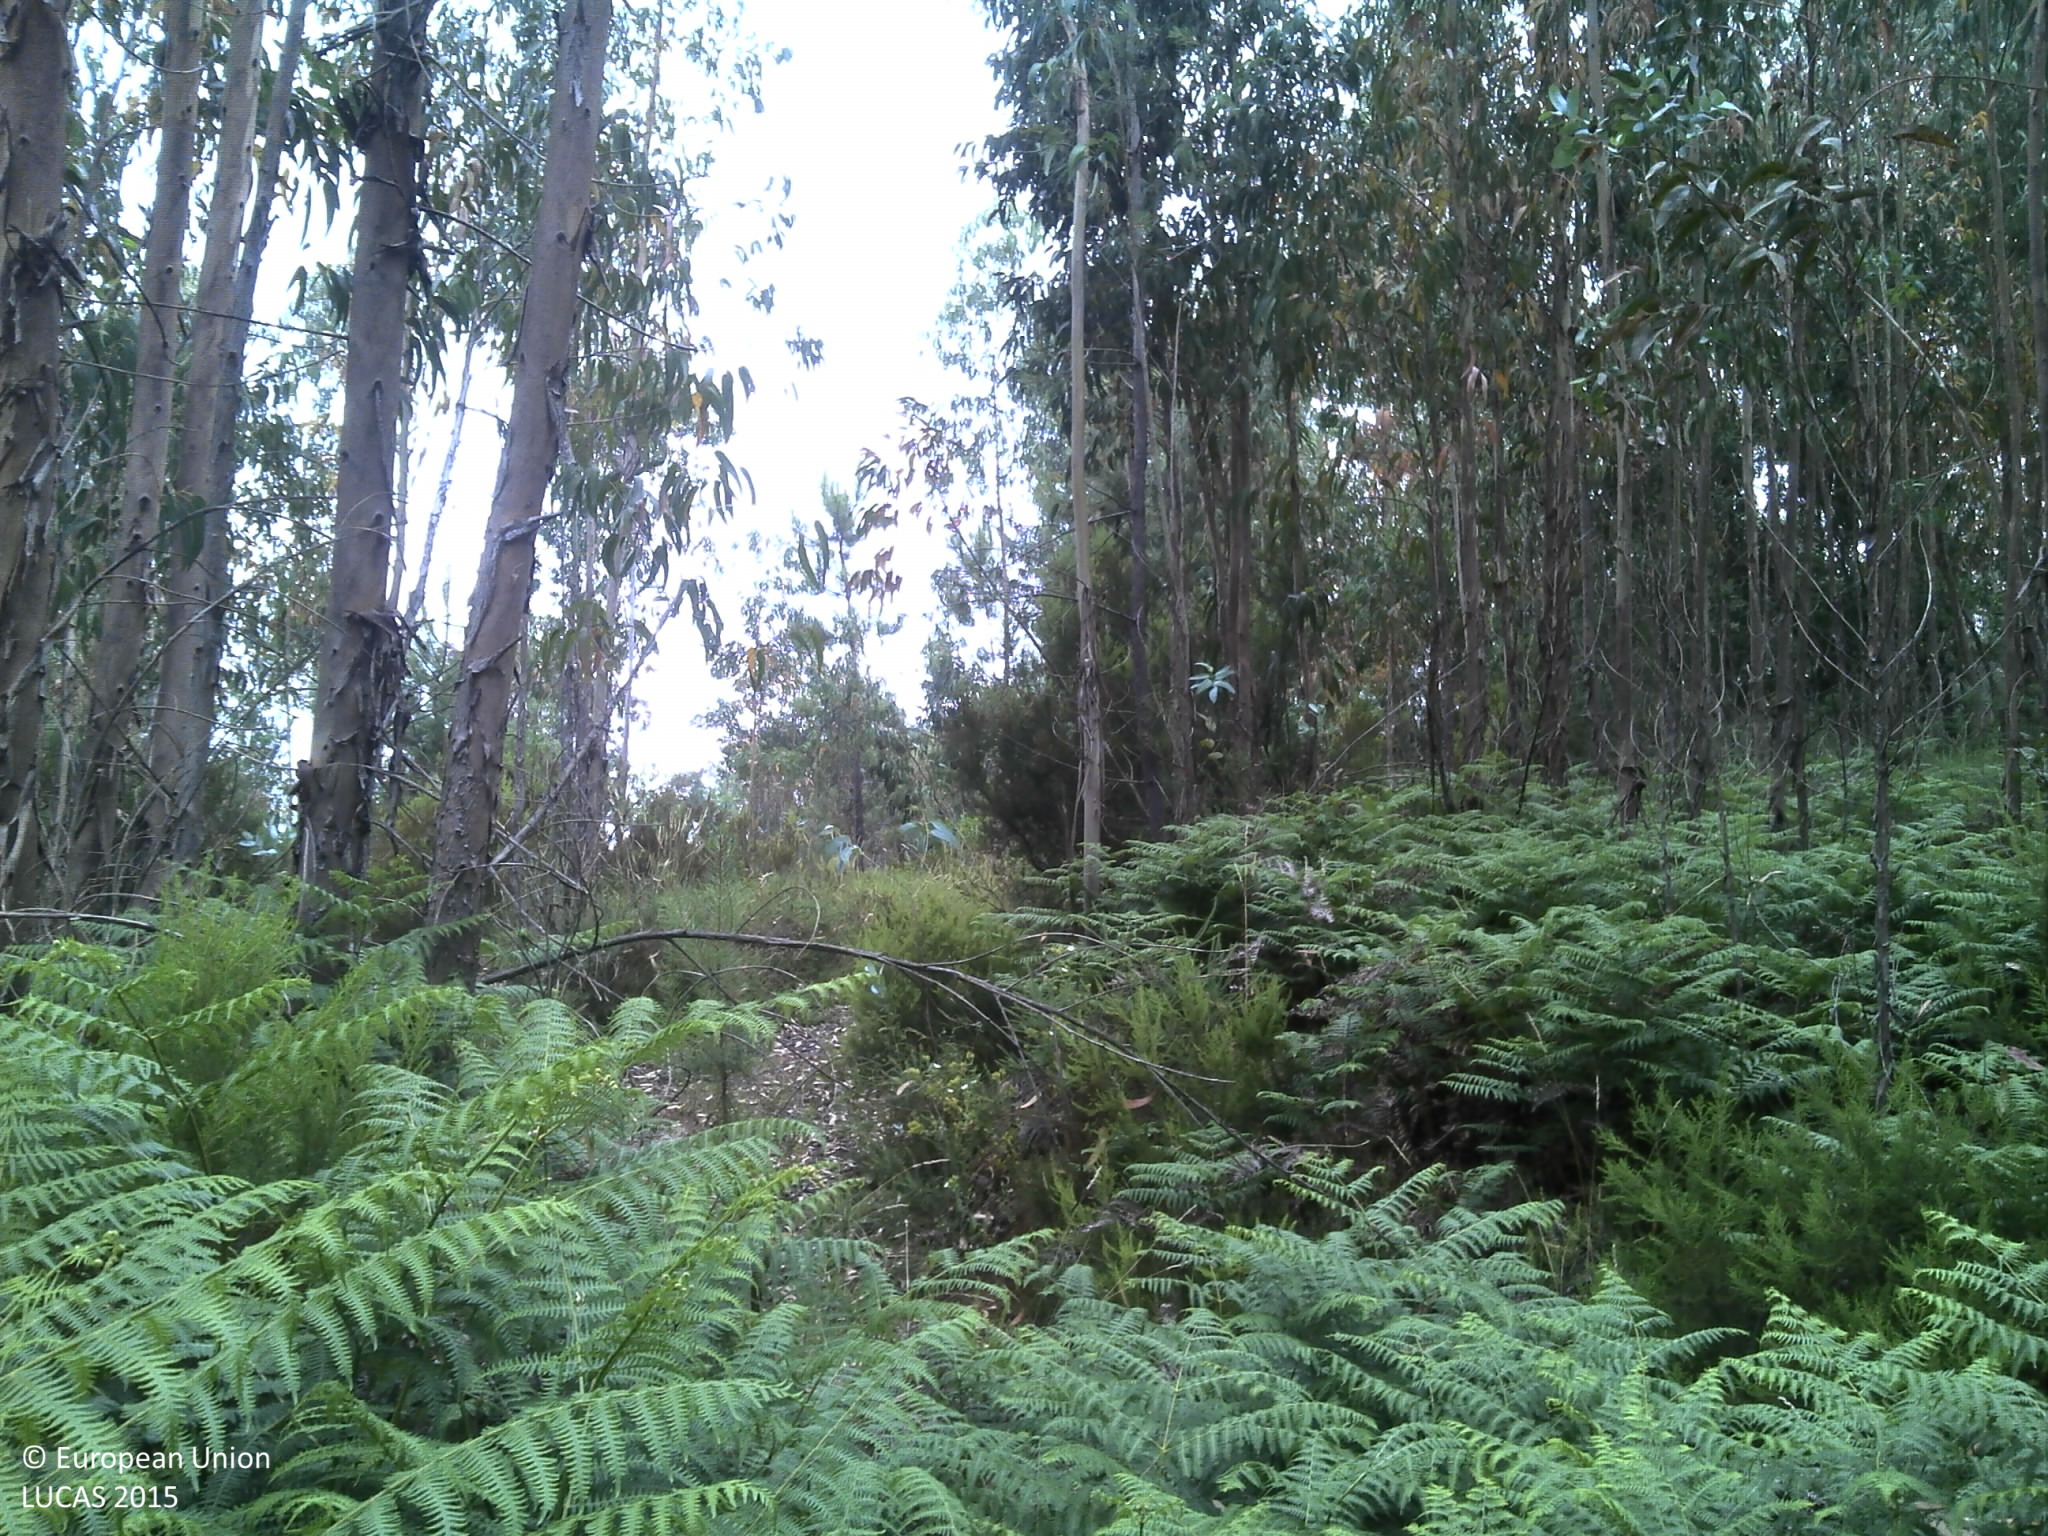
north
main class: Woodland
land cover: Broadleaved woodland
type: exotic forest
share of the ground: 50 - 75 %
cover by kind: broadleaved forest trees 70 %, shrubs 20 %, herbaceous plants 5 %, unconsolidated bare surface 5 %
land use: Forestry
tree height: > 5 m
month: June
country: PT
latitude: 40.4390
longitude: -8.3709
